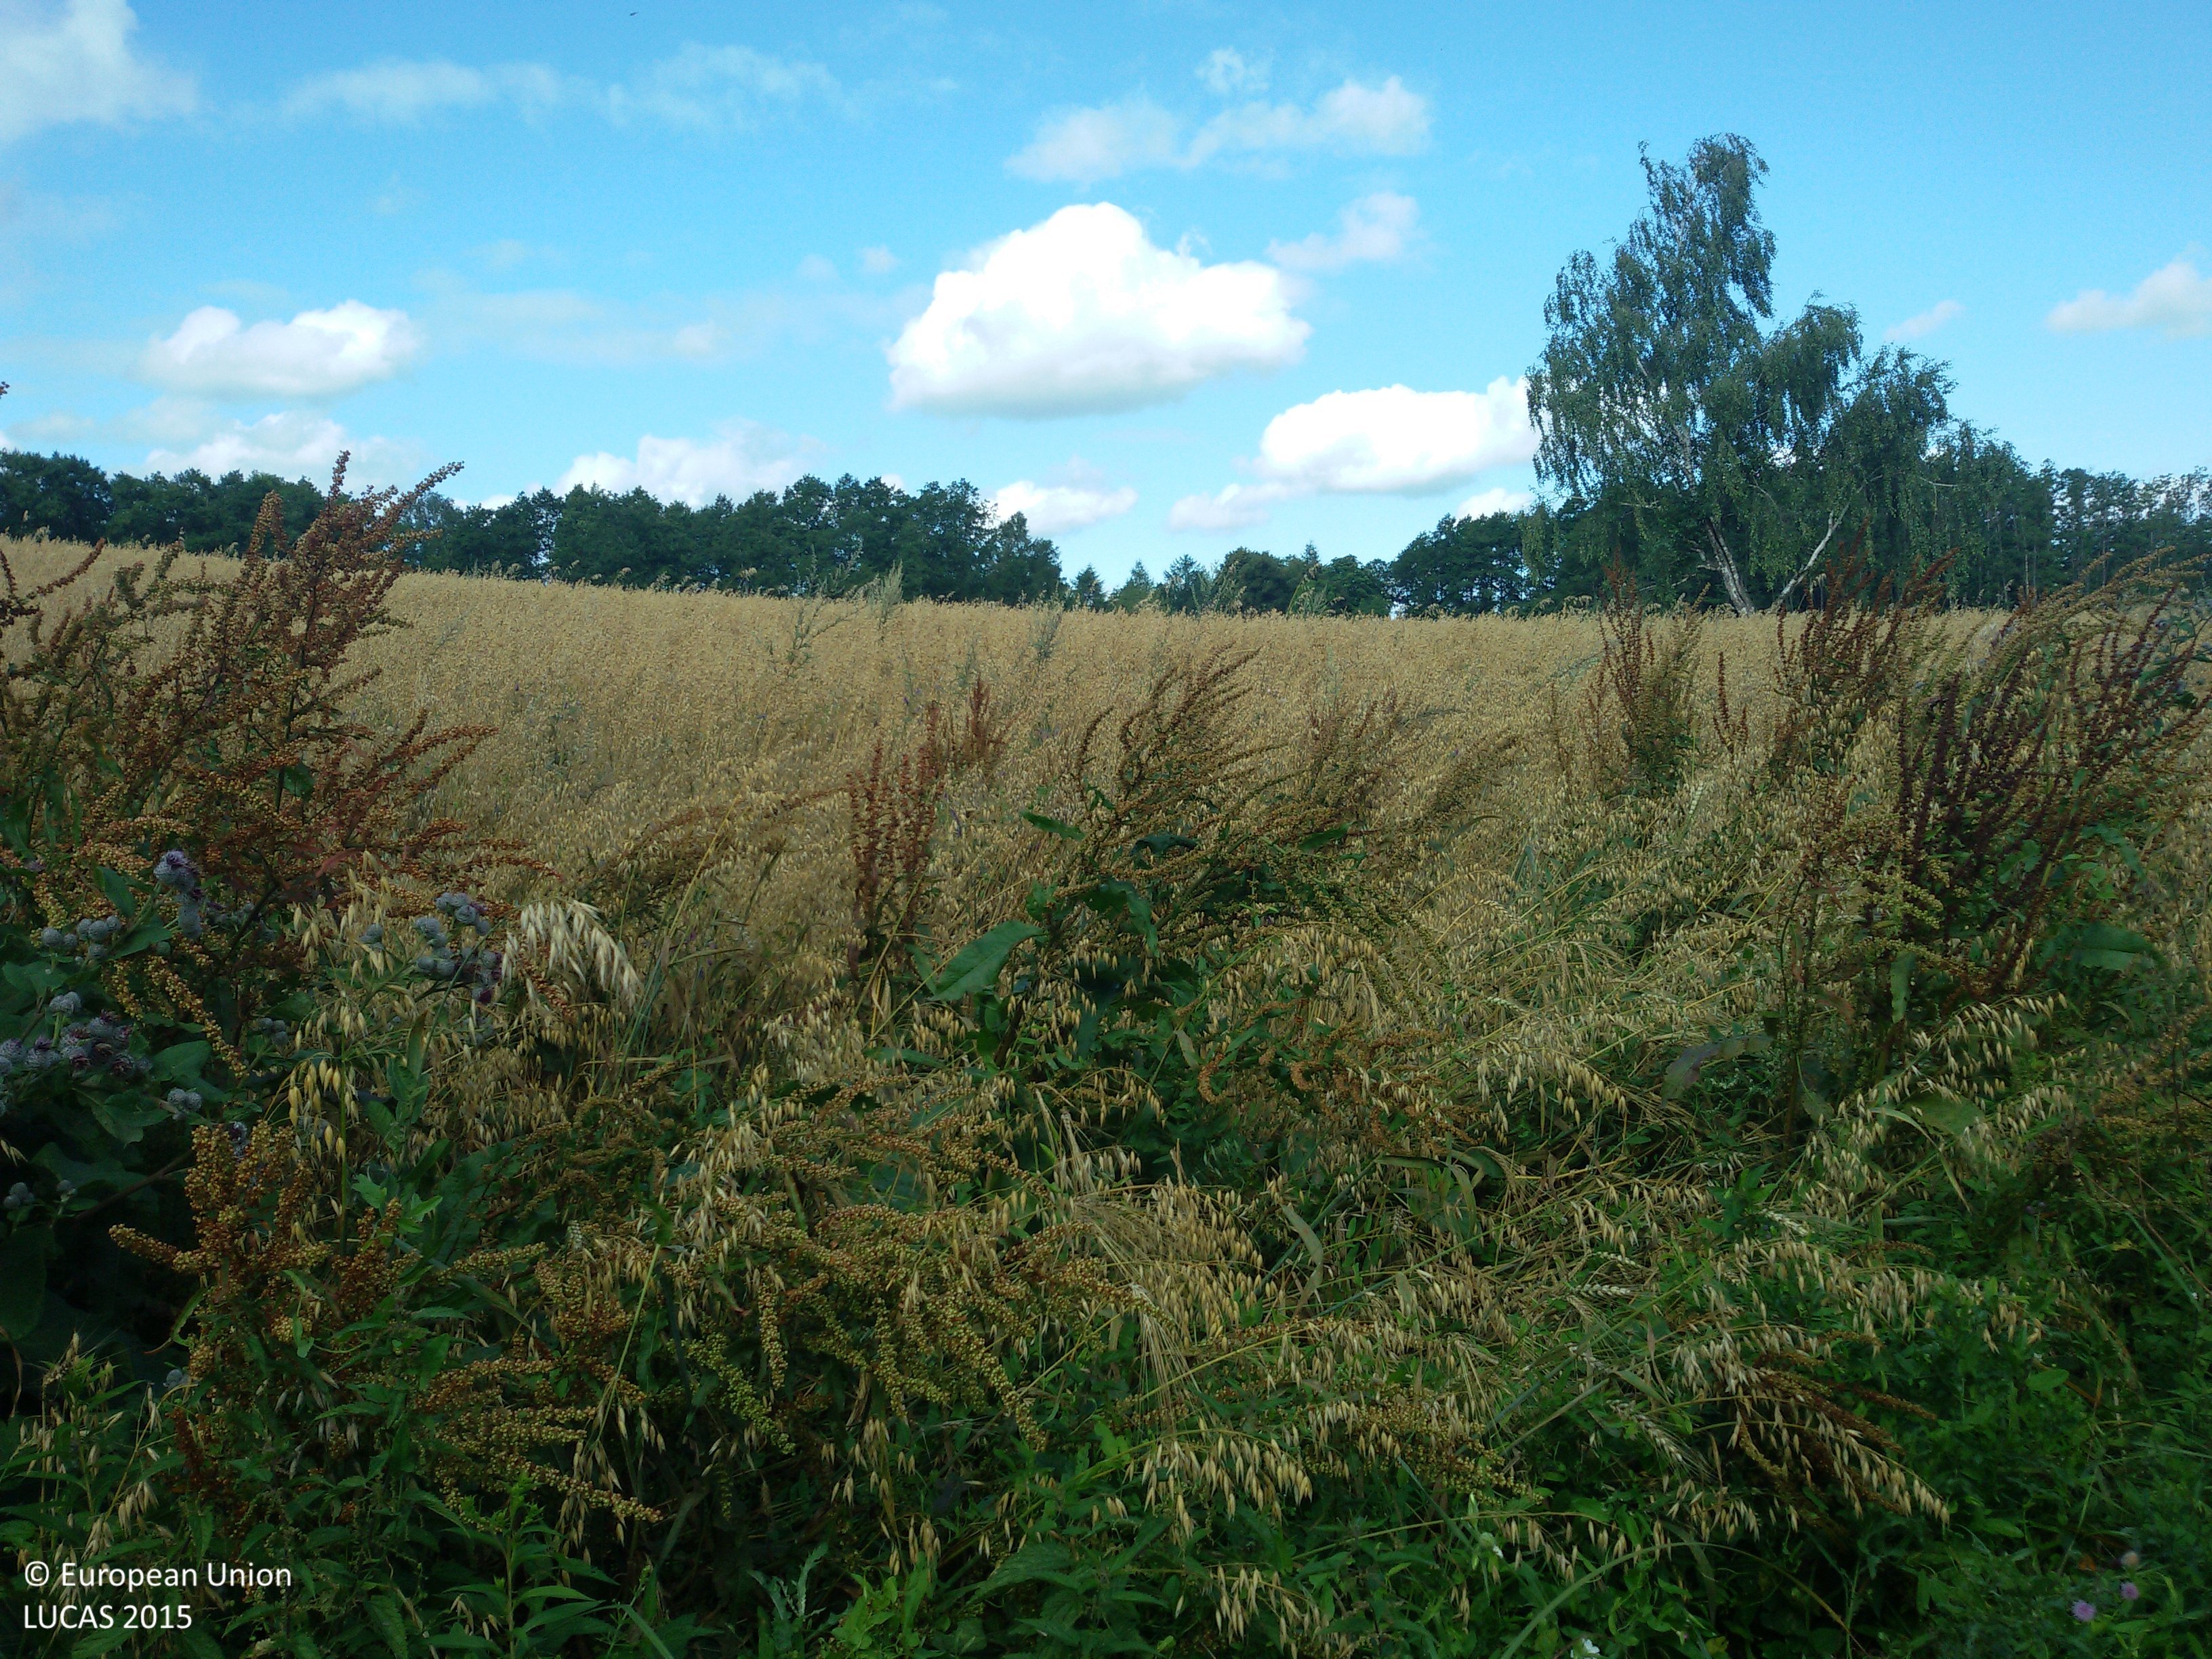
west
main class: Grassland
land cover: Spontaneously vegetated surfaces
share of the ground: > 75 %
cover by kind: herbaceous plants 95 %, shrubs 5 %
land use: Semi-natural and natural areas not in use
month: July
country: PL
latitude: 52.8932
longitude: 19.1355
